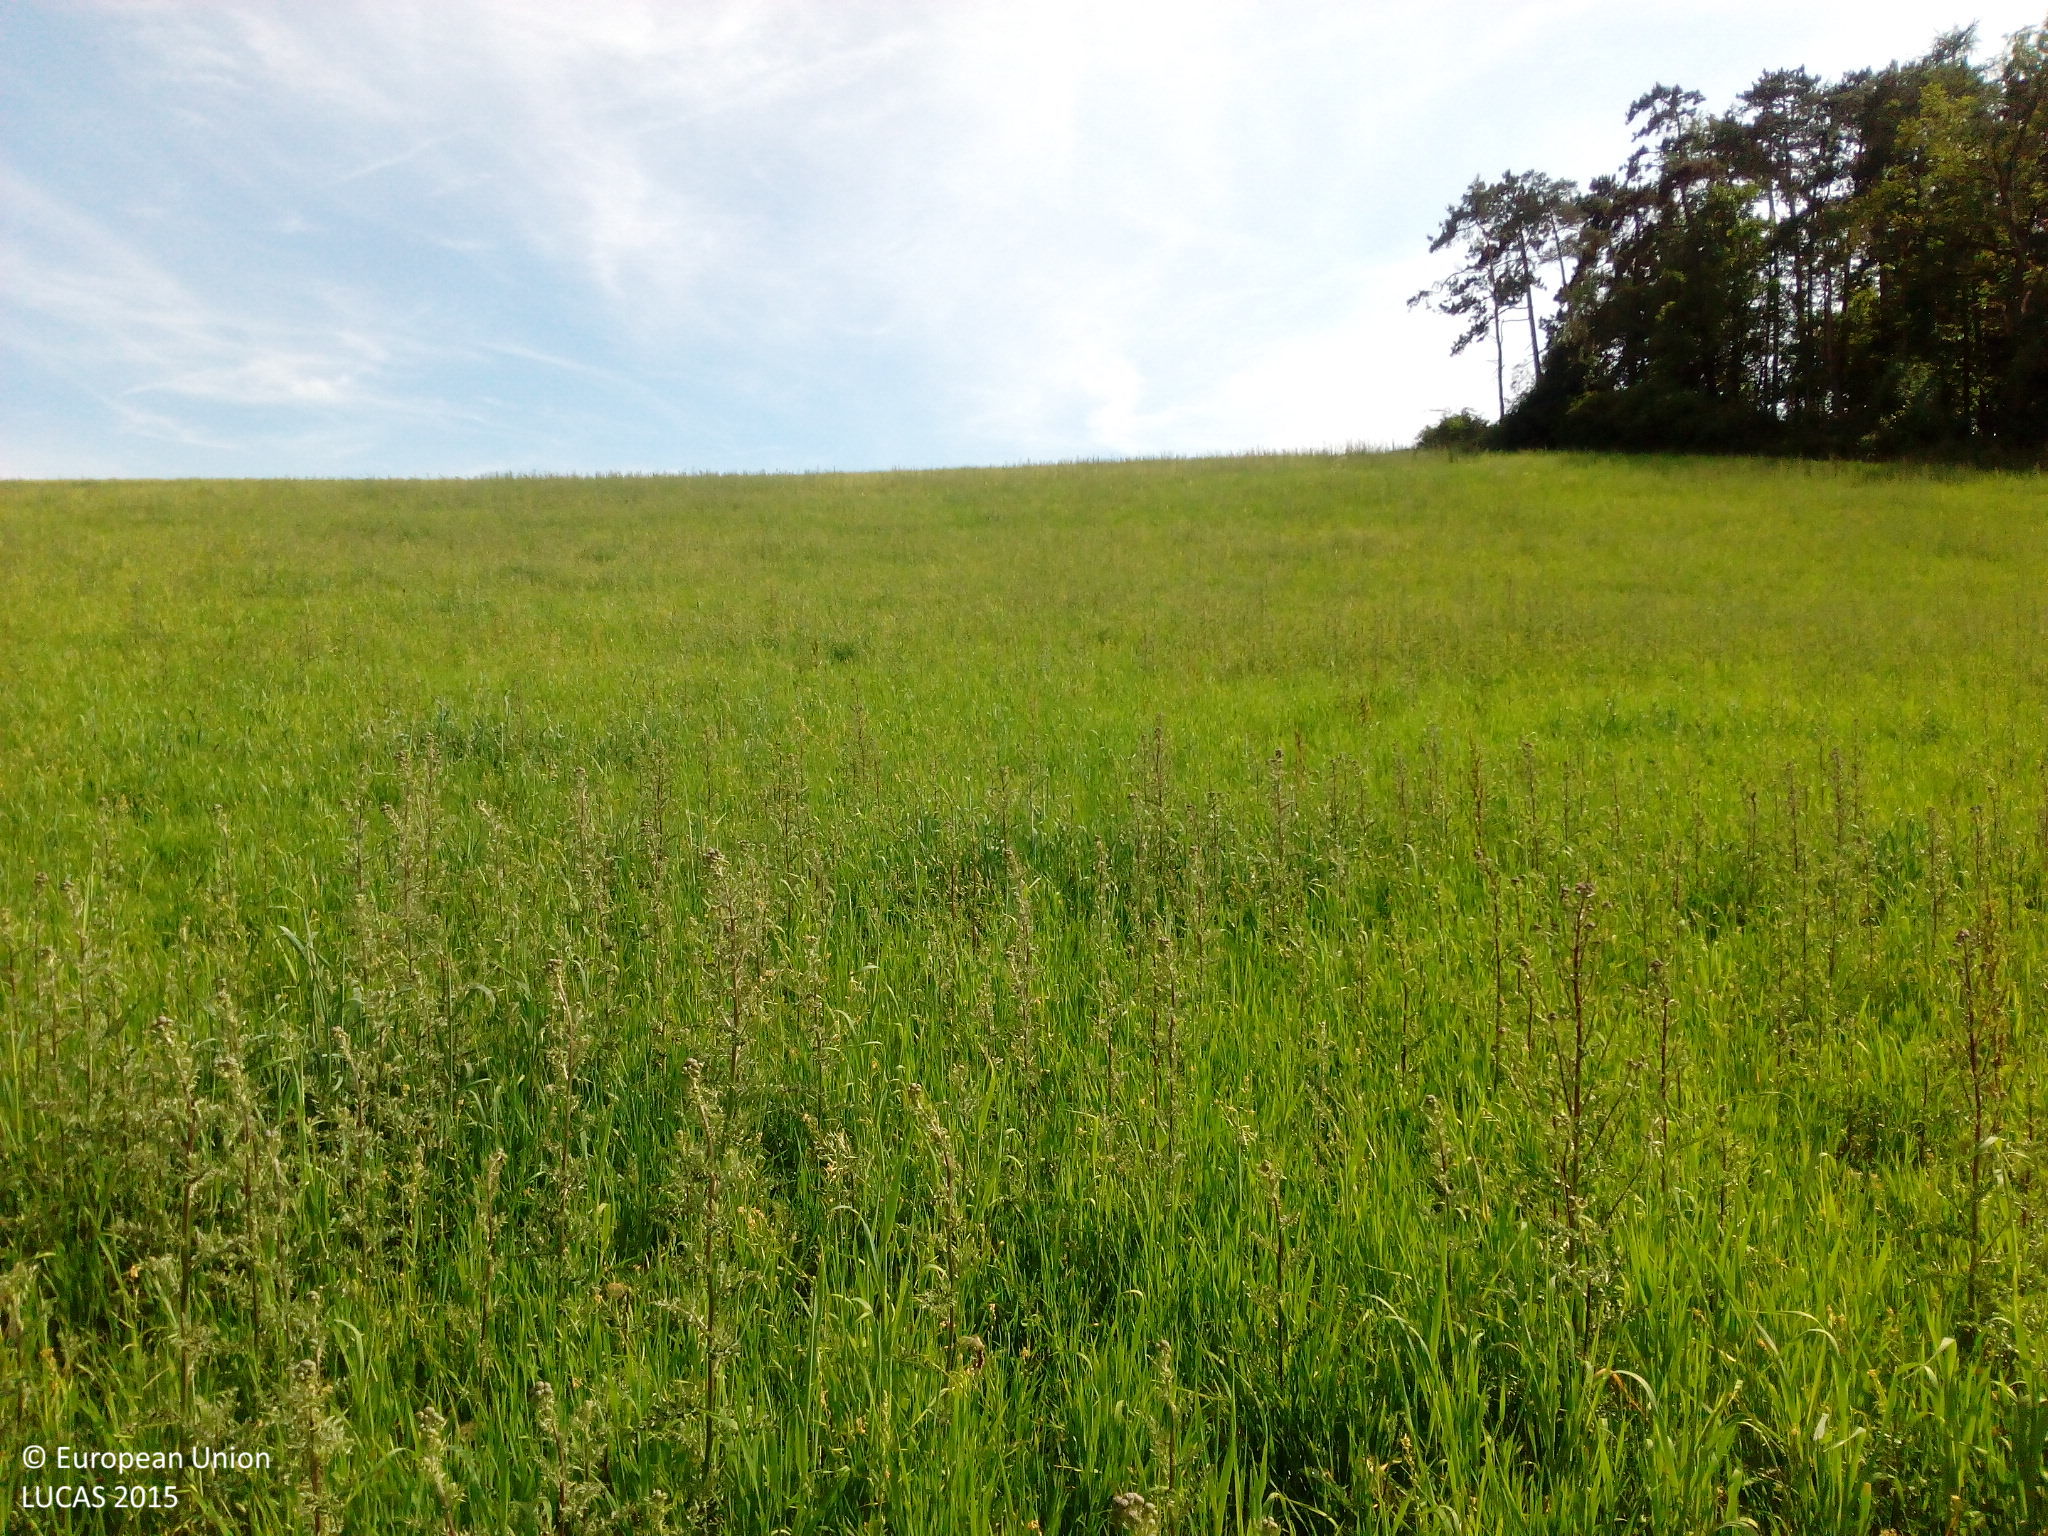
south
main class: Cropland
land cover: Common wheat
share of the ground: > 75 %
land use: Agriculture (excluding fallow land and kitchen gardens)
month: June
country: DE
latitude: 49.5000
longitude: 9.5721
